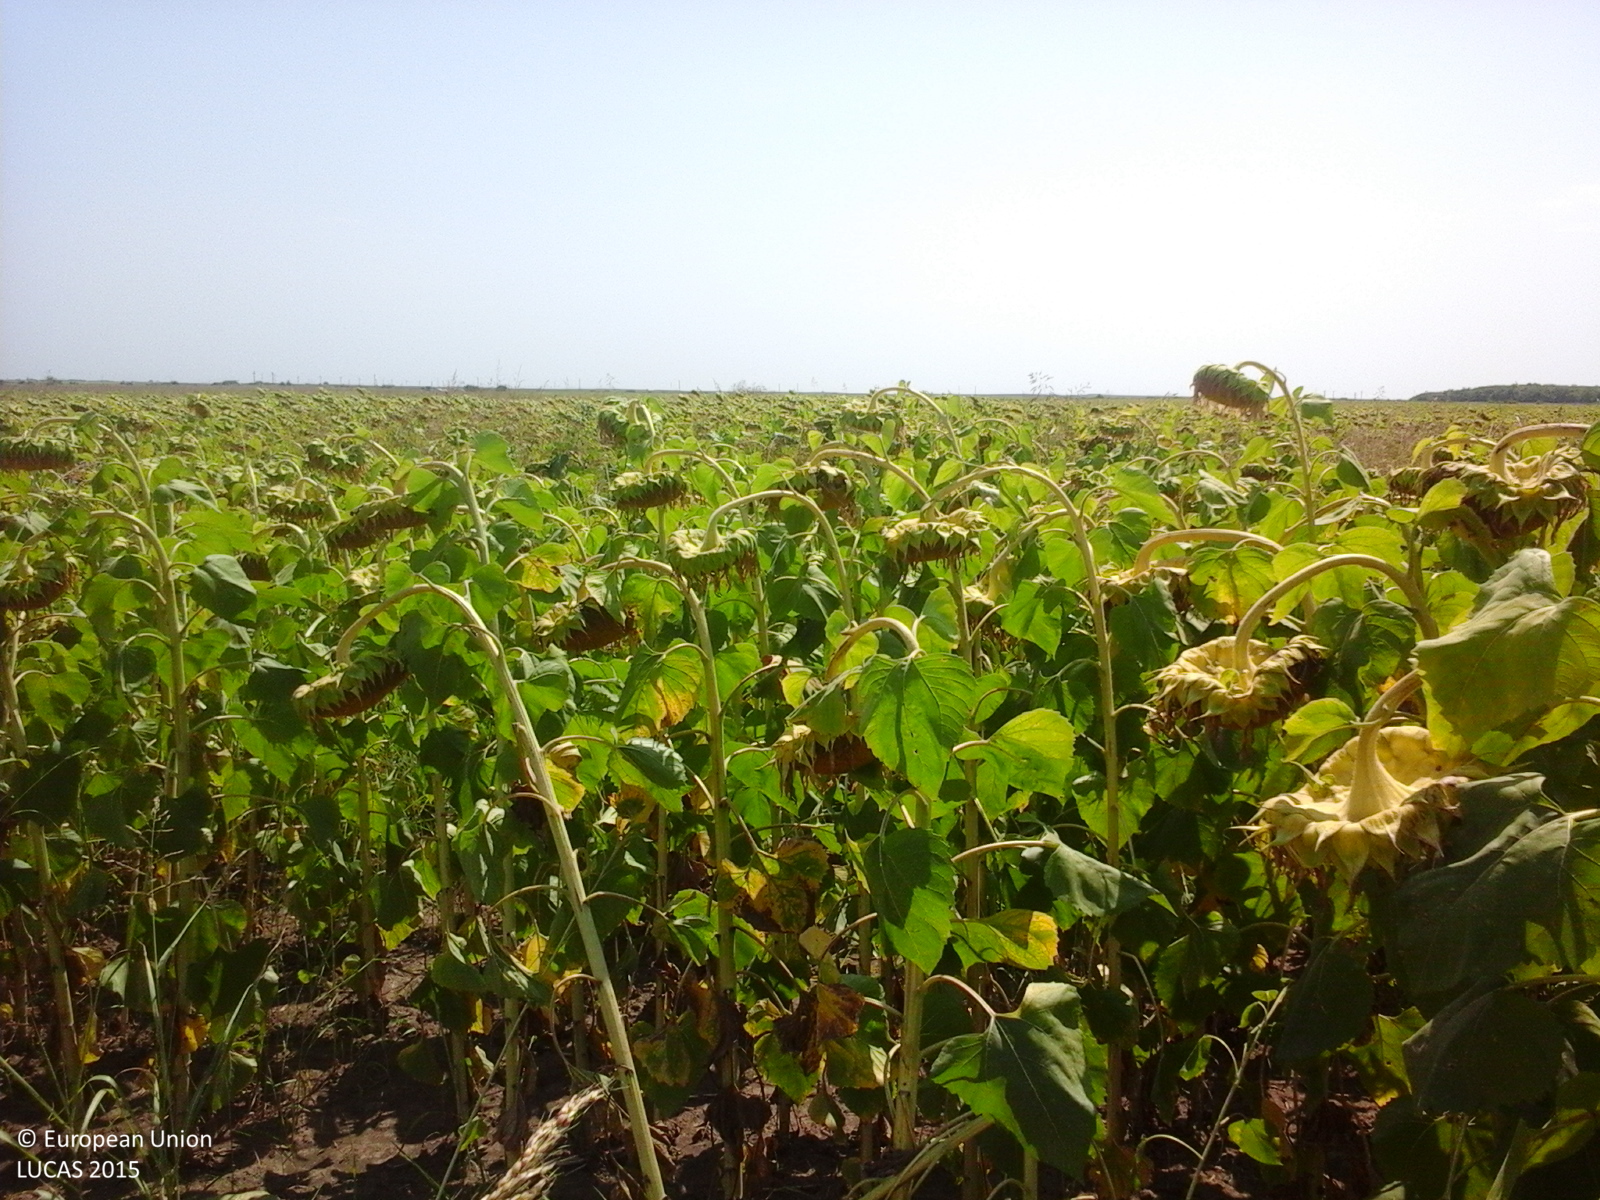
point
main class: Cropland
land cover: Sunflower
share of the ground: > 75 %
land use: Agriculture (excluding fallow land and kitchen gardens)
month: August
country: RO
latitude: 45.2903
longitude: 27.7678
